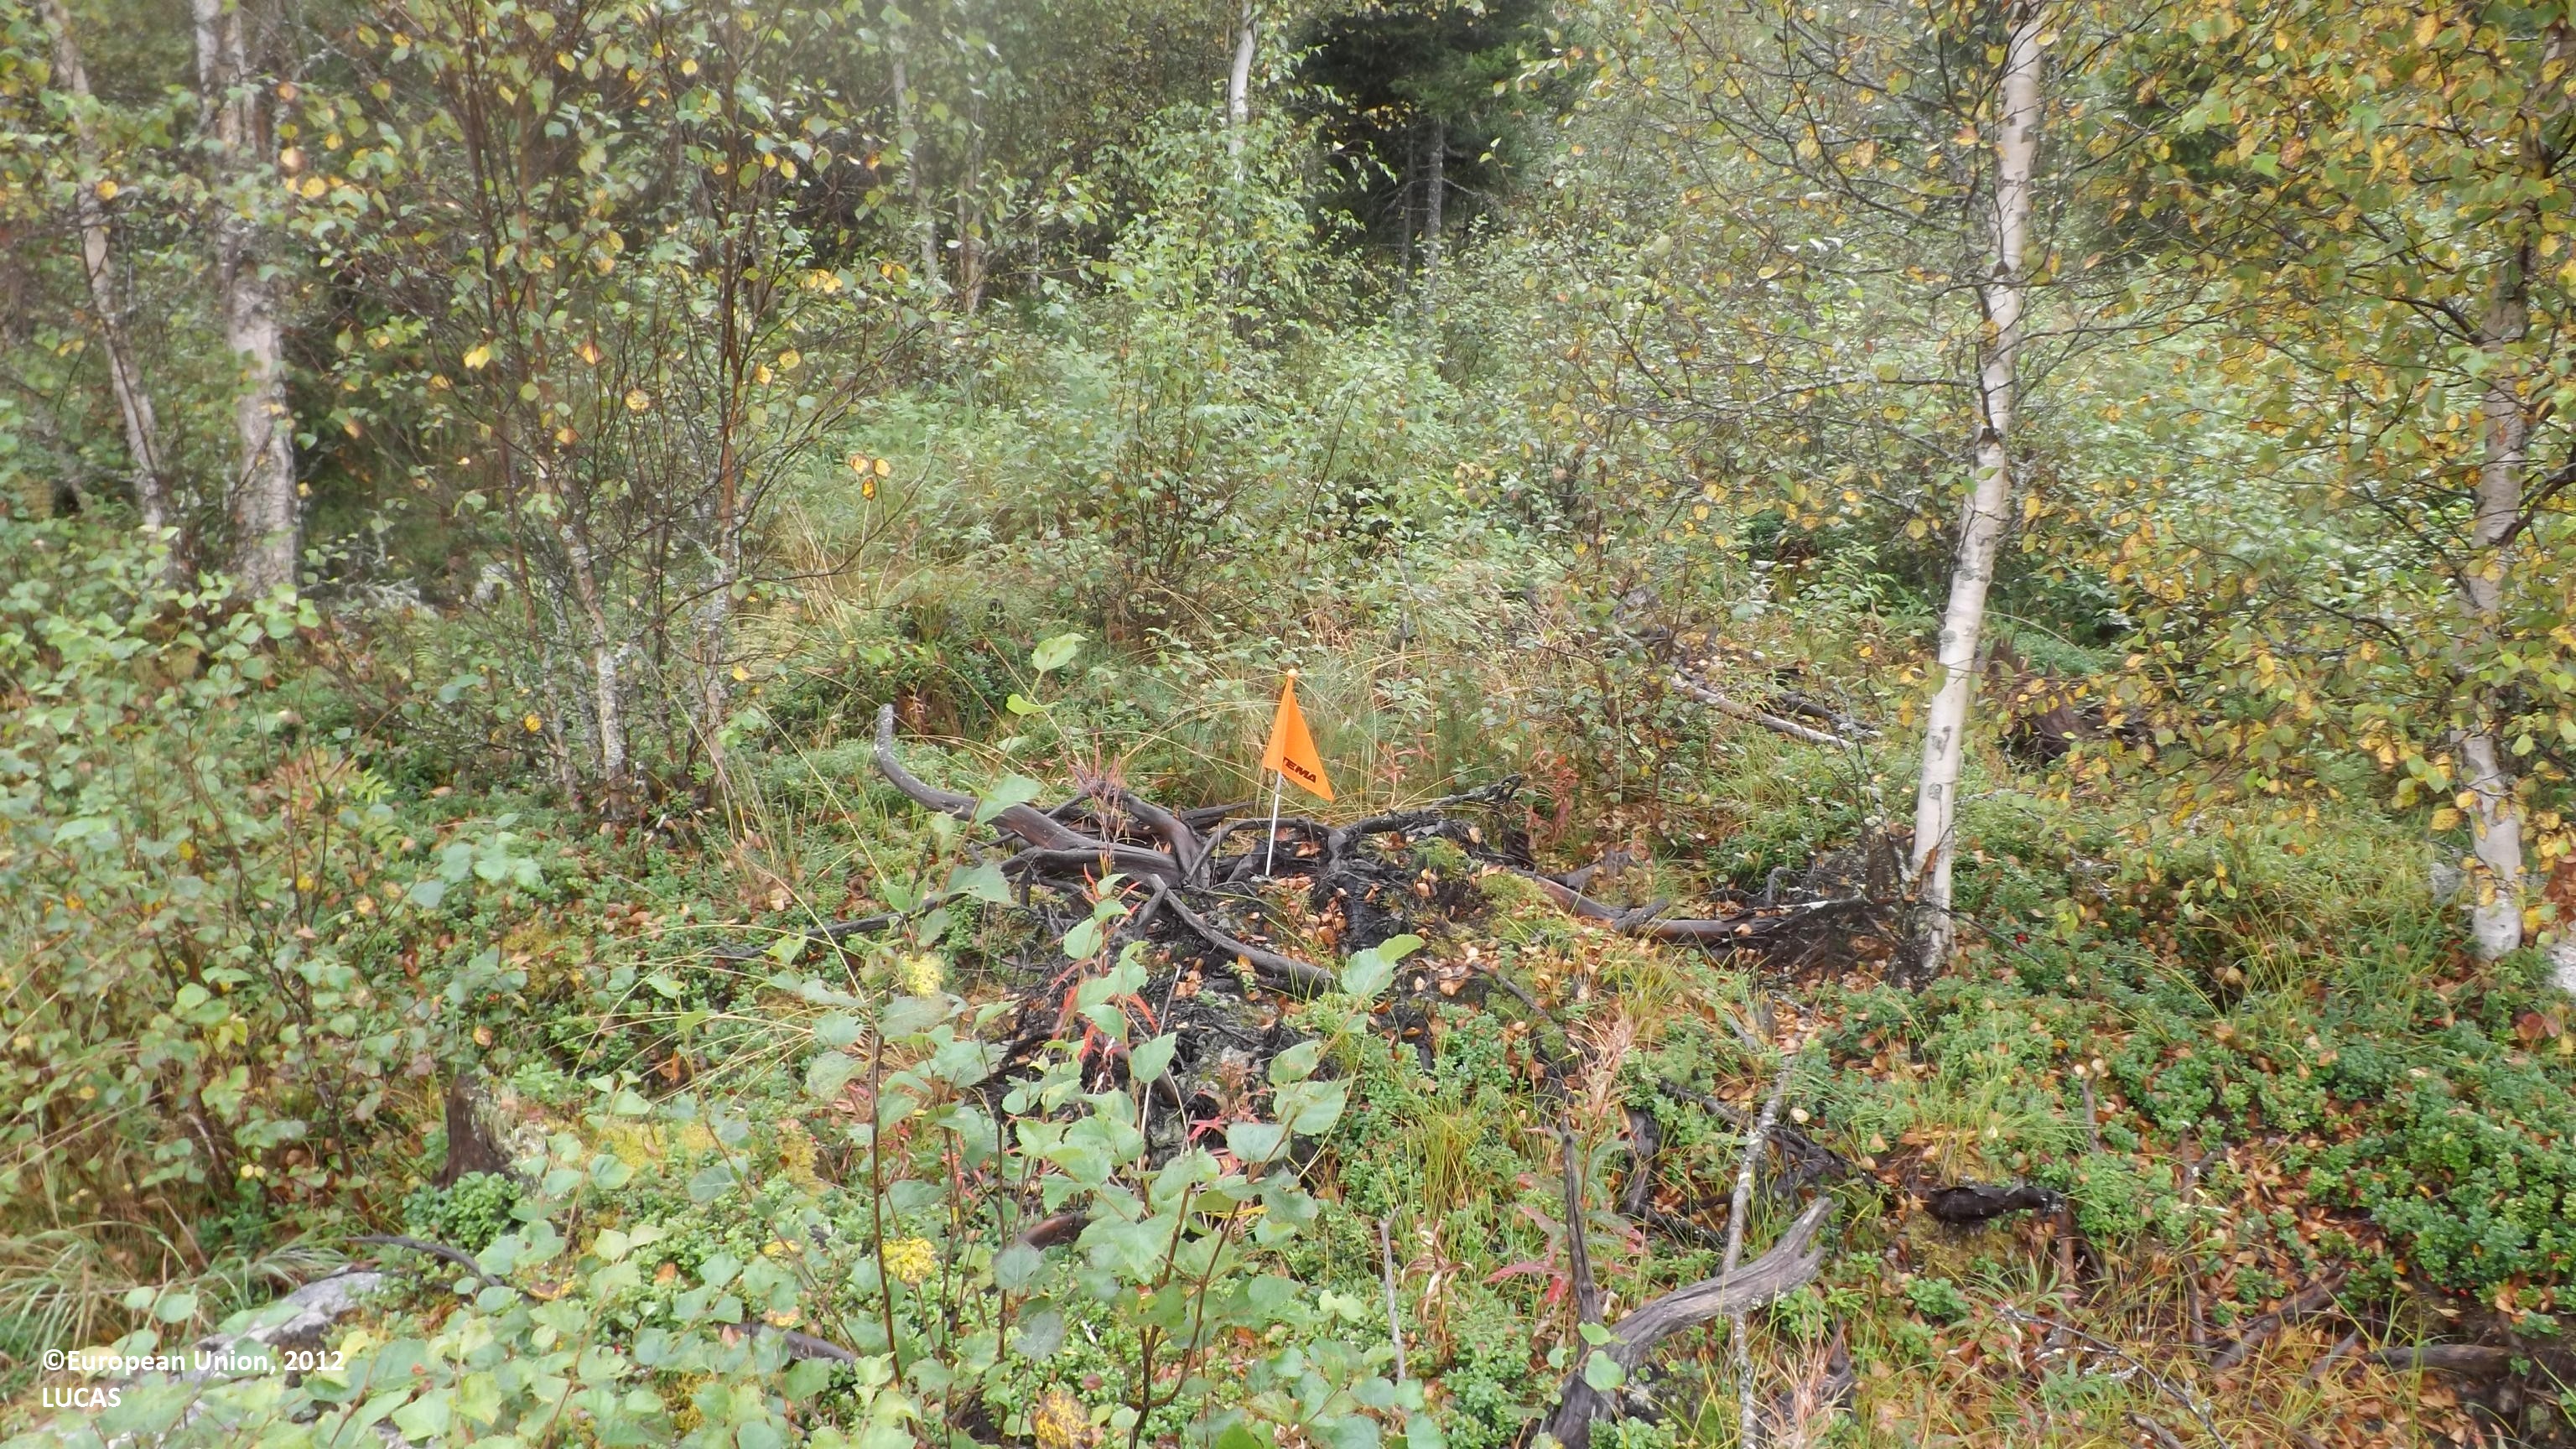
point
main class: Shrubland
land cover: Shrubland with sparse tree cover
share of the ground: 50 - 75 %
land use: Forestry
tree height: < 5 m
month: August
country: FI
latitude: 63.8053
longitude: 23.6452
